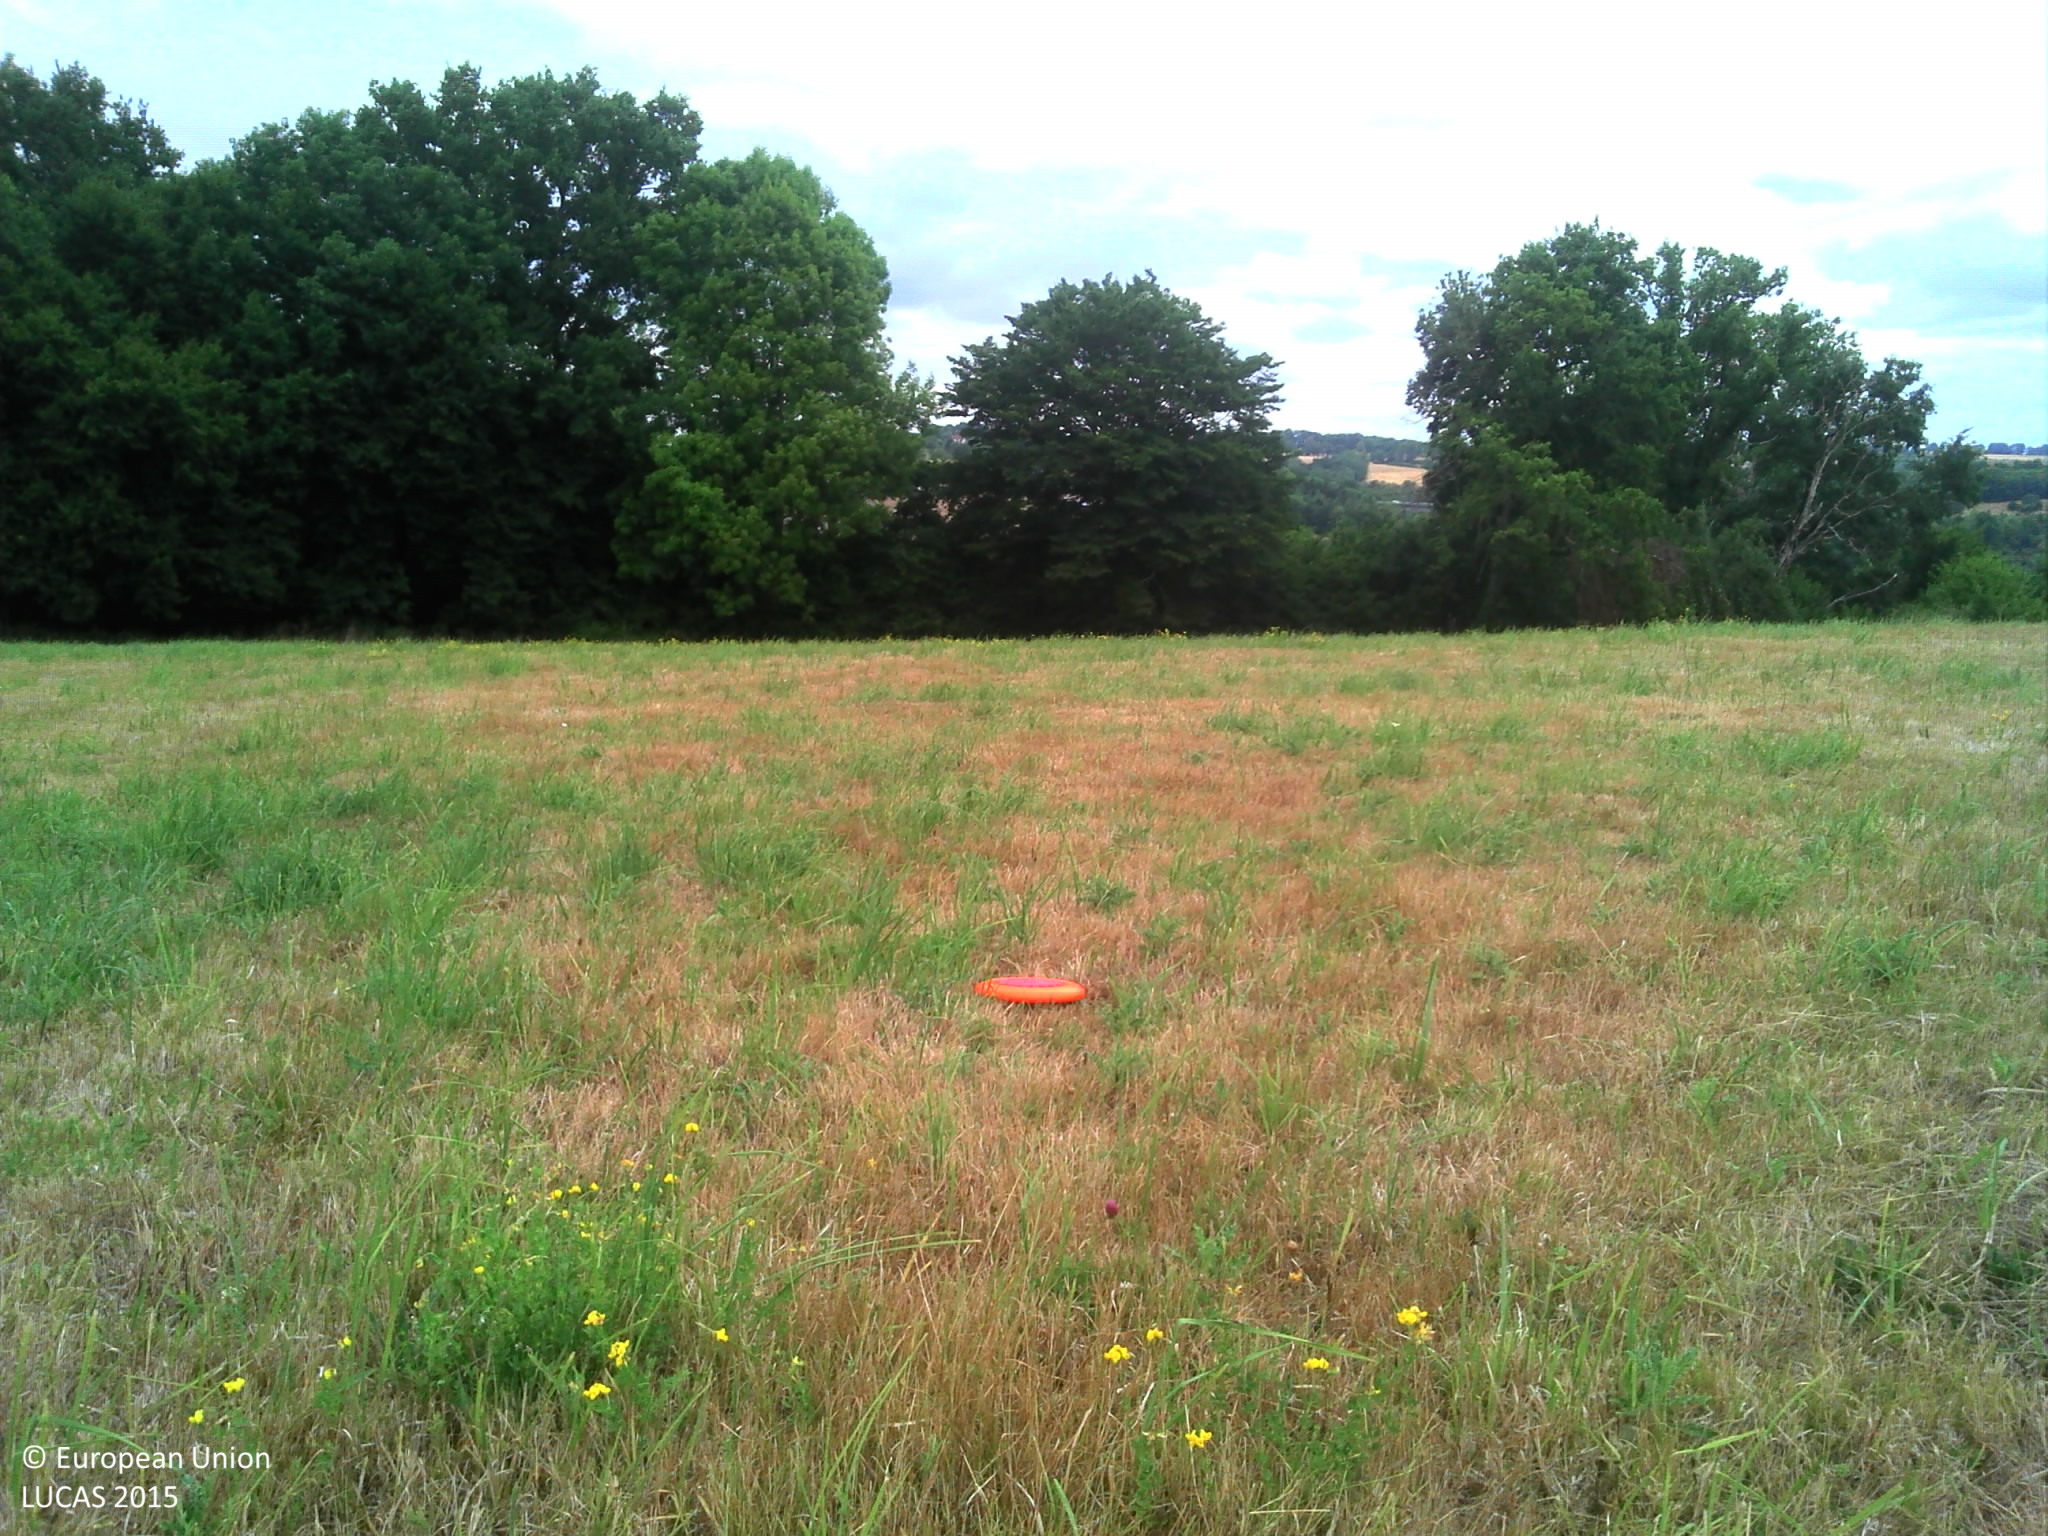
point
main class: Grassland
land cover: Grassland without tree/shrub cover
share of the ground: > 75 %
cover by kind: herbaceous plants 95 %
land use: Agriculture (excluding fallow land and kitchen gardens)
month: July
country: FR
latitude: 45.6923
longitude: 1.3496
